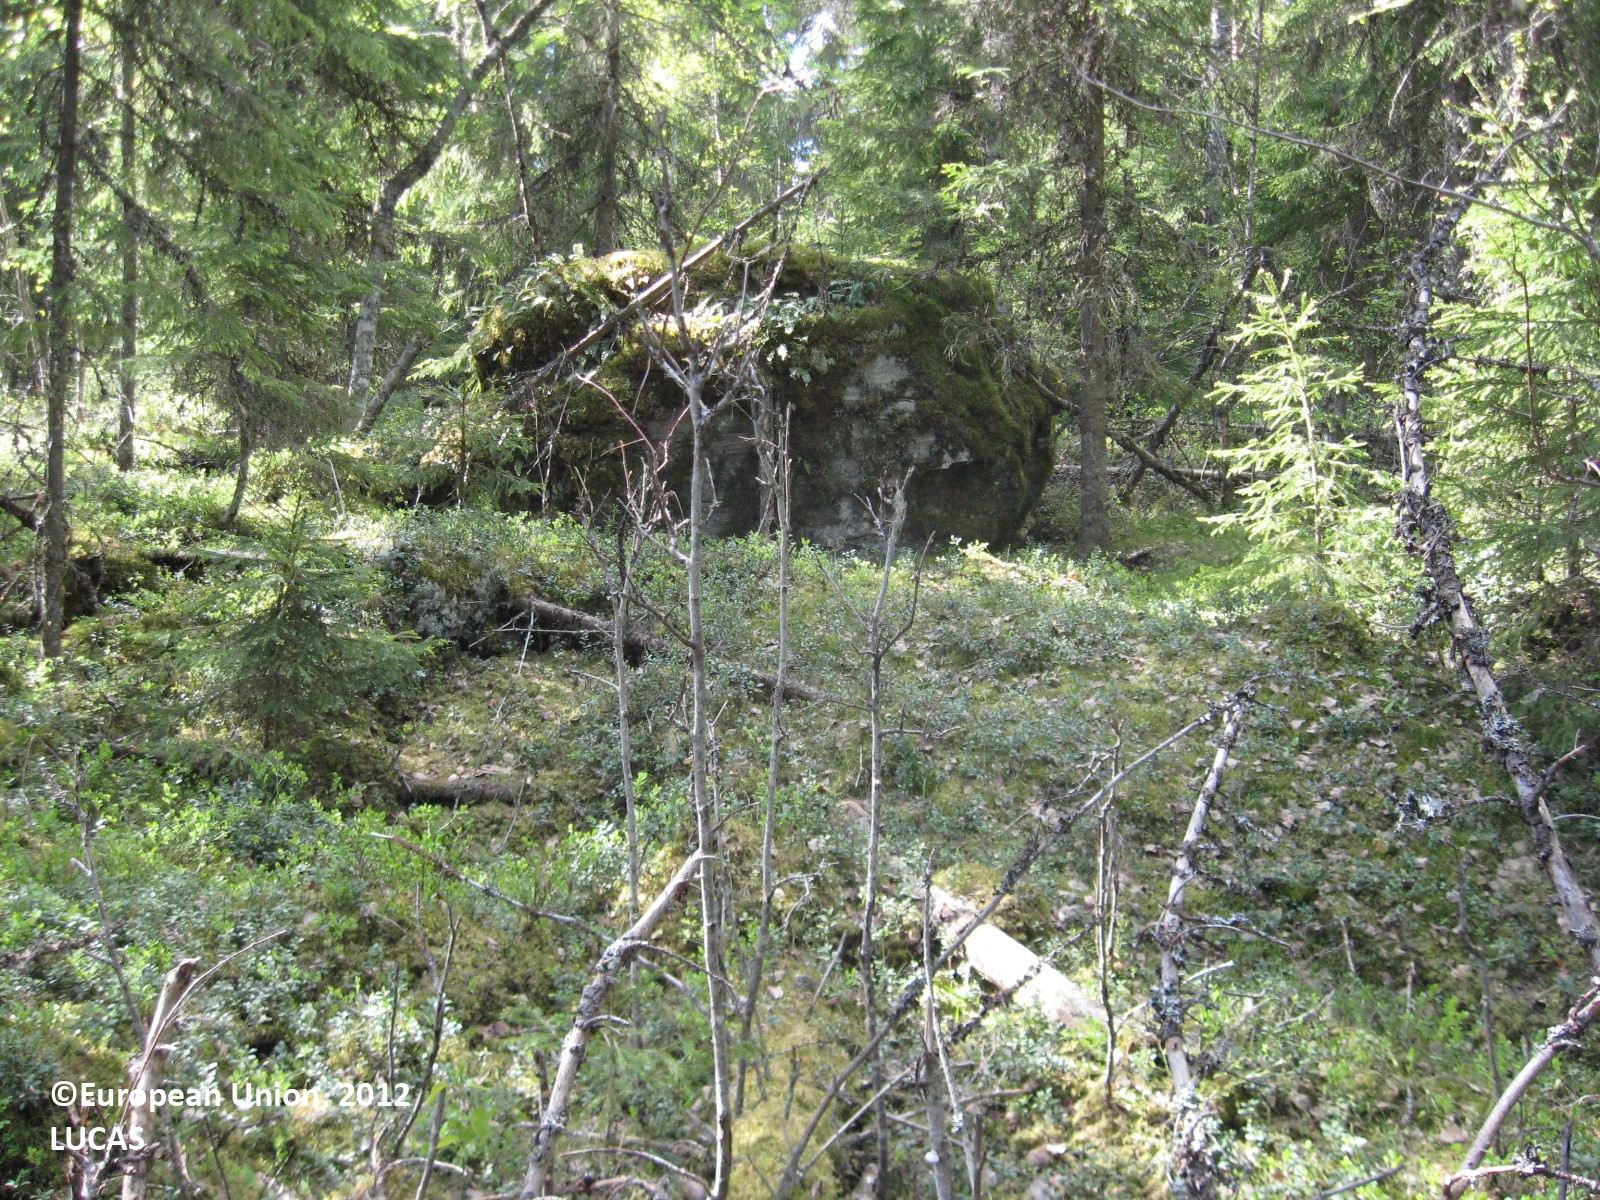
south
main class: Woodland
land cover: Spruce dominated coniferous woodland
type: boreal forest
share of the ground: 50 - 75 %
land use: Forestry
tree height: > 5 m
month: May
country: FI
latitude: 61.7343
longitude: 22.1527
